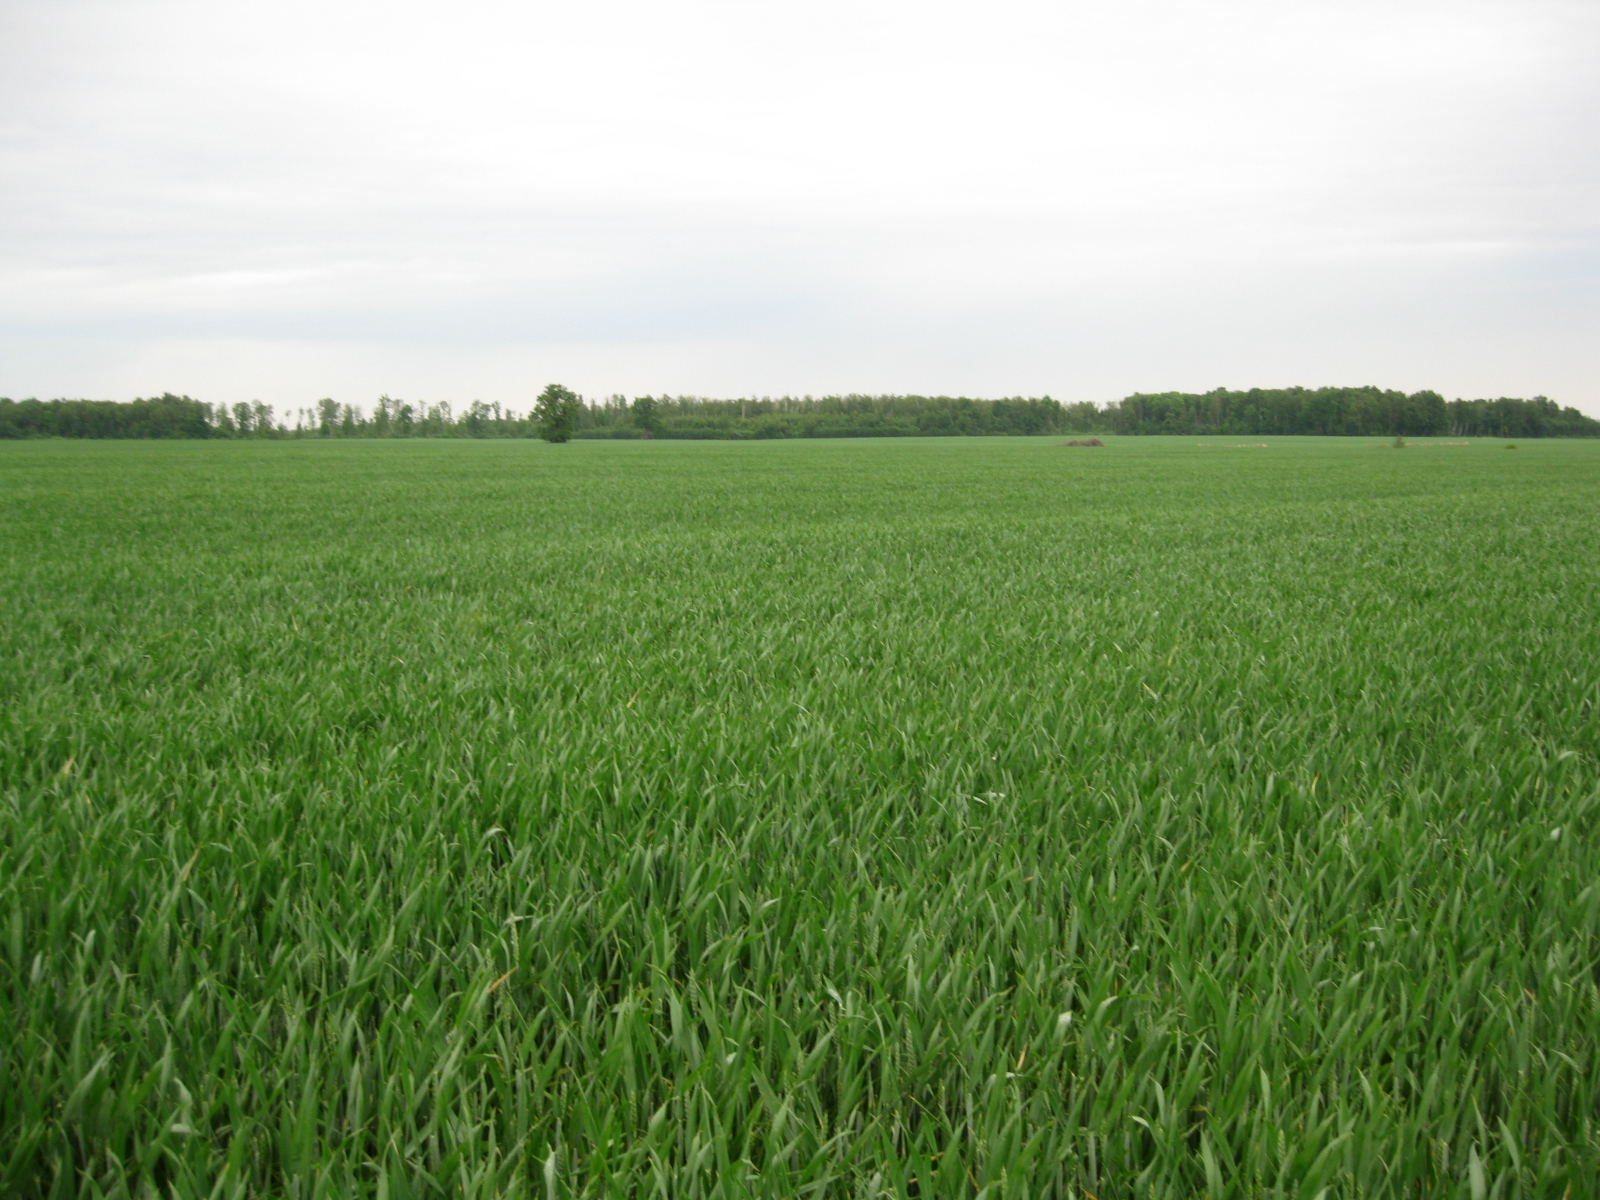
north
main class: Cropland
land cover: Common wheat
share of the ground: > 75 %
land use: Agriculture (excluding fallow land and kitchen gardens)
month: June
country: LT
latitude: 55.6461
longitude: 23.8945
